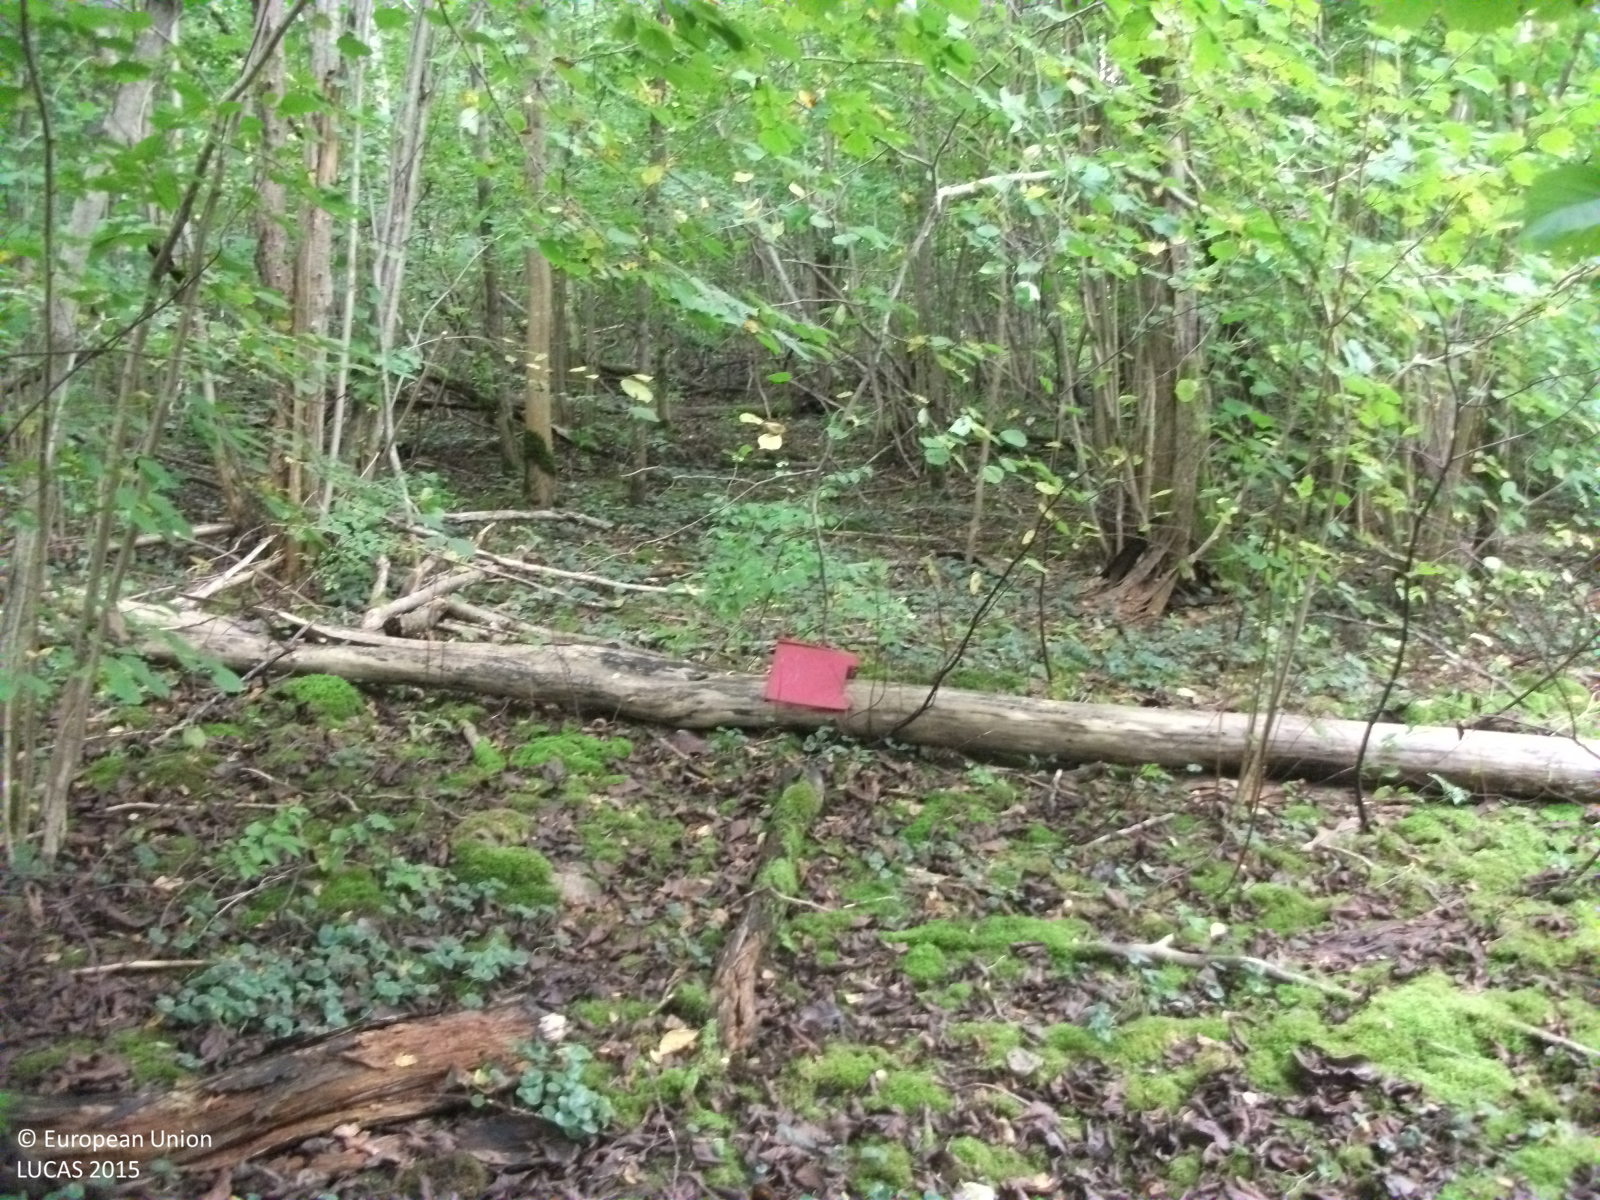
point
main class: Woodland
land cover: Broadleaved woodland
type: floodplain forest
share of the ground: 50 - 75 %
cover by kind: broadleaved forest trees 70 %, herbaceous plants 10 %, shrubs 5 %, lichens and mosses 5 %, unconsolidated bare surface 5 %
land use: Semi-natural and natural areas not in use
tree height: > 5 m
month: September
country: LV
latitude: 57.7614
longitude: 24.4592
